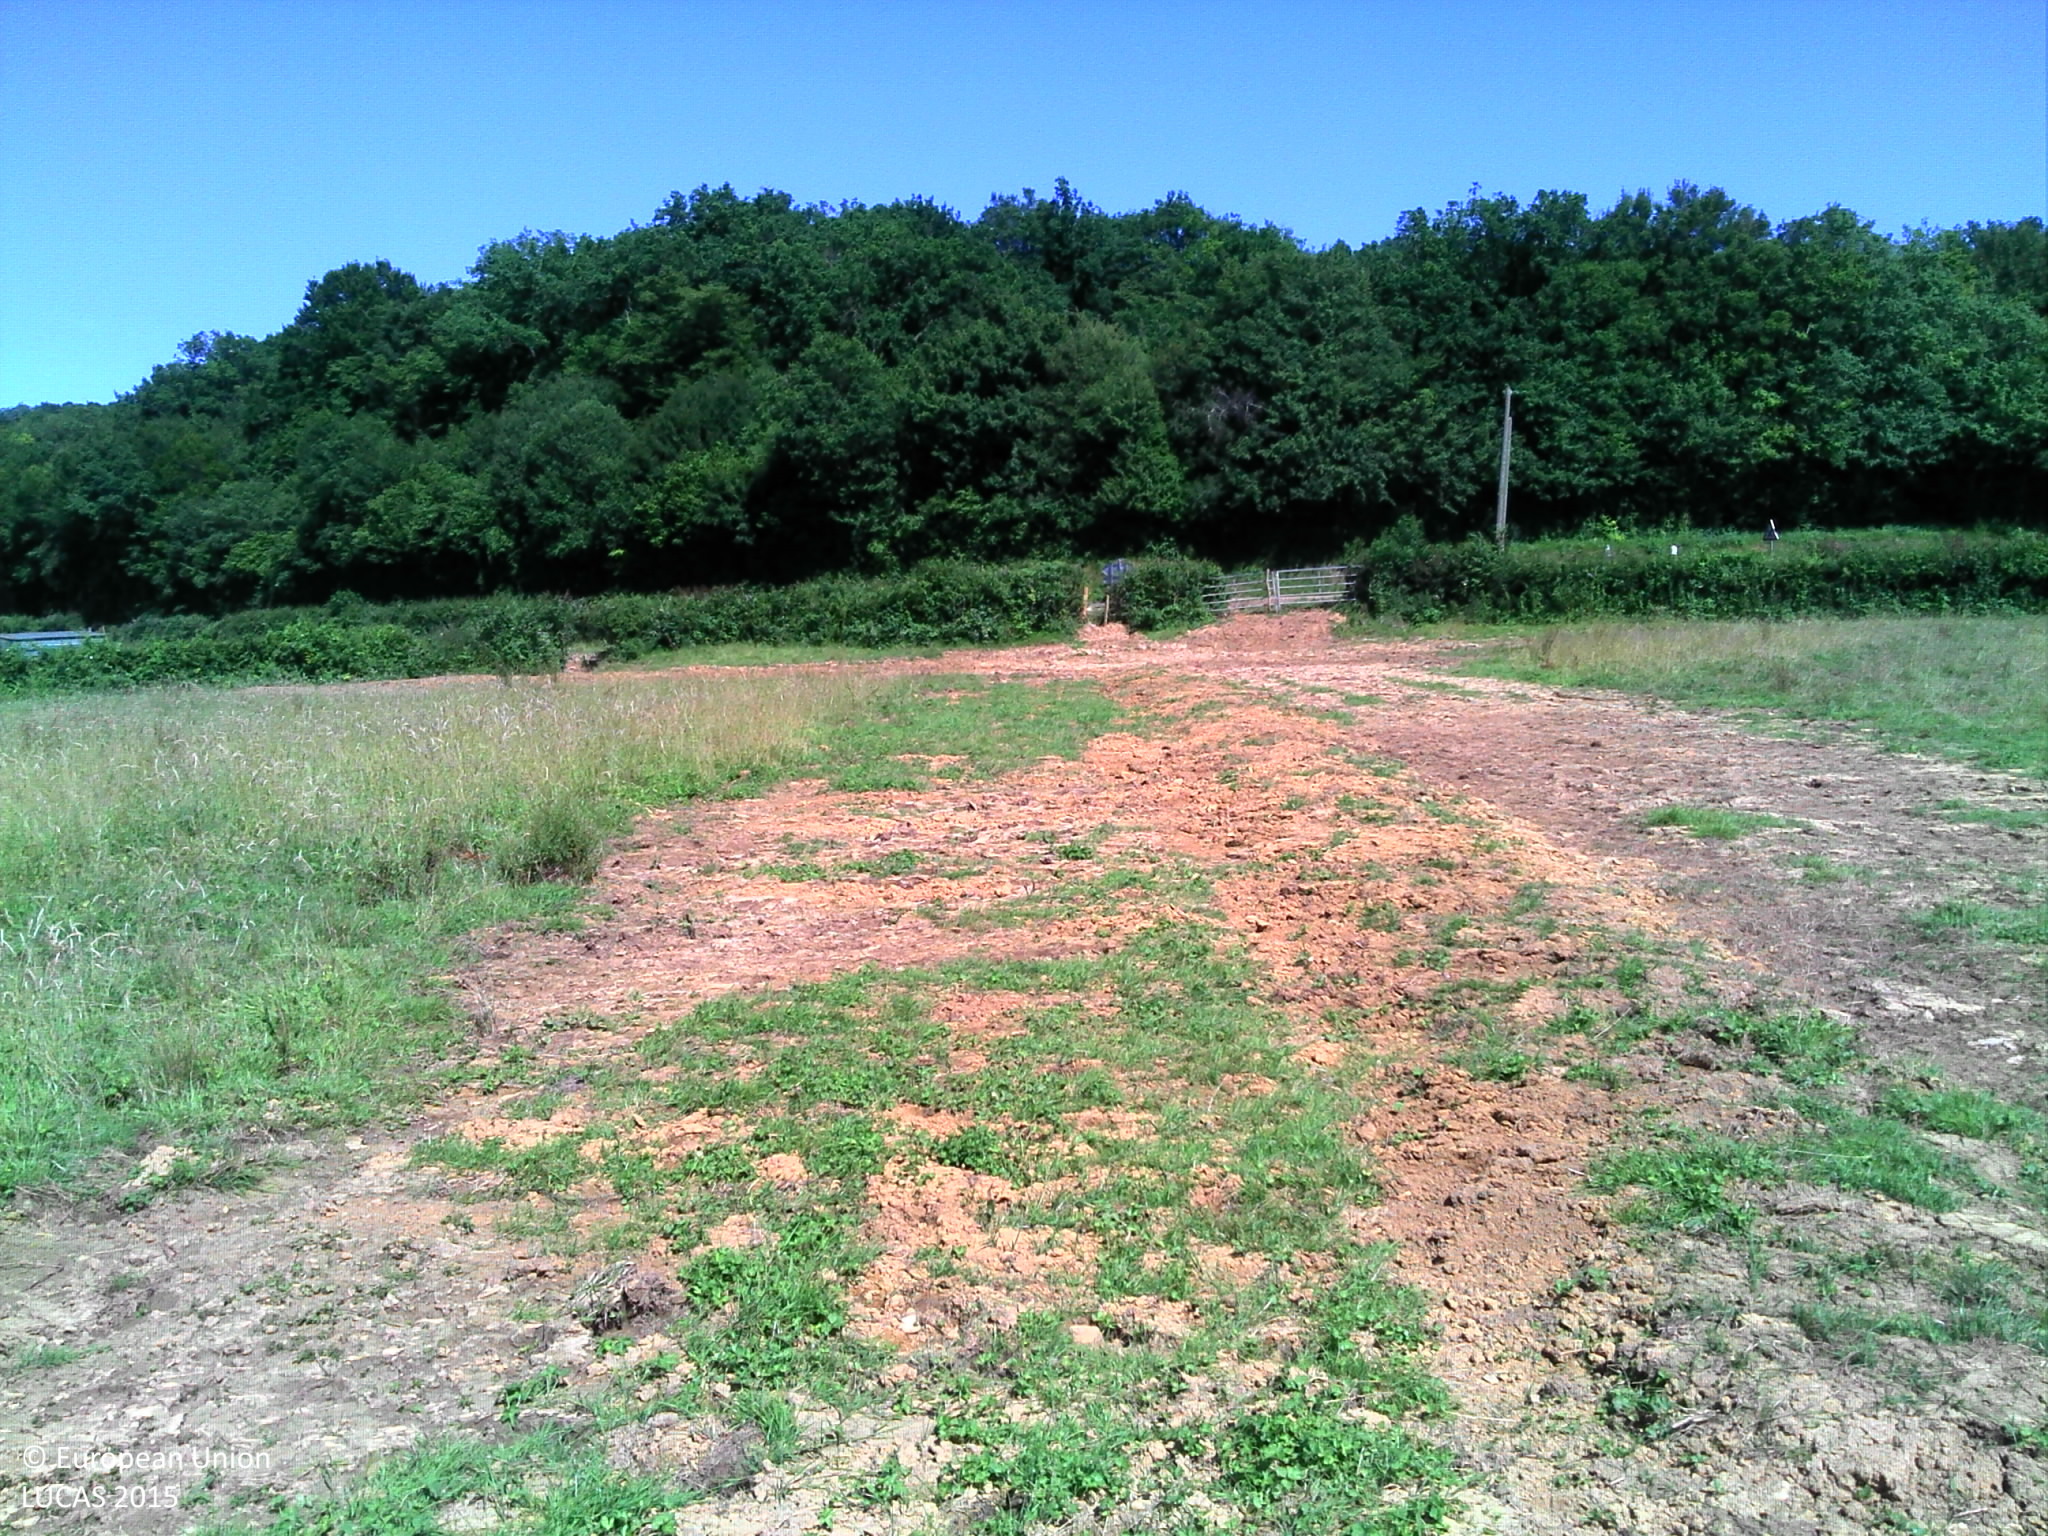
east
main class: Grassland
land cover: Grassland without tree/shrub cover
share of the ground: > 75 %
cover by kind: herbaceous plants 100 %
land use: Agriculture (excluding fallow land and kitchen gardens)
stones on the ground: < 10 %
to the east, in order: Grassland without tree/shrub cover; Fences; Managed hedges; Grassland without tree/shrub cover; Fences; Managed hedges; Grass margins; Paved roads, cycling and walking lanes; Electric lines; Ditches and canals; Broadleaved woodland
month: June
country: FR
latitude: 47.3634
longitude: 3.4952
